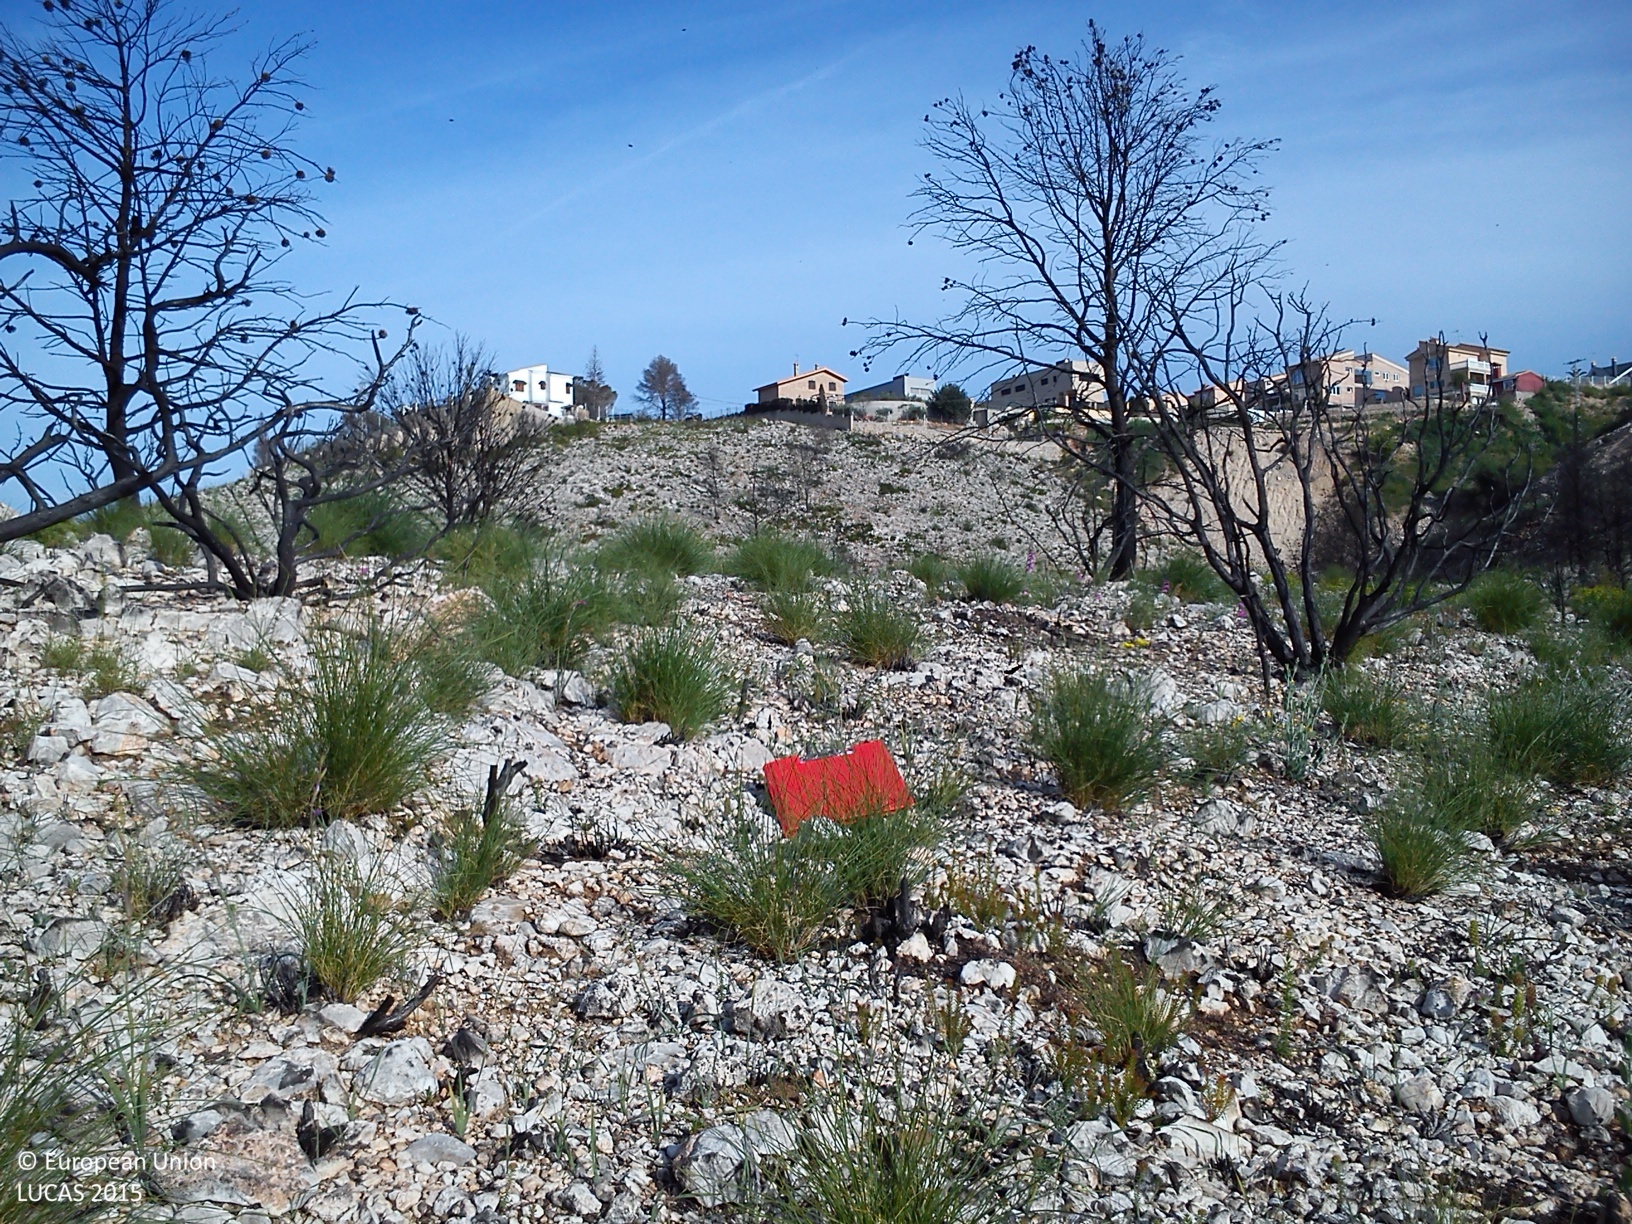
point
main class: Grassland
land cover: Spontaneously vegetated surfaces
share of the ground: 25 - 50 %
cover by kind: consolidated bare surface 70 %, herbaceous plants 30 %
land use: Semi-natural and natural areas not in use
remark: Burnt area
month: April
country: ES
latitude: 39.4380
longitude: -0.5825
